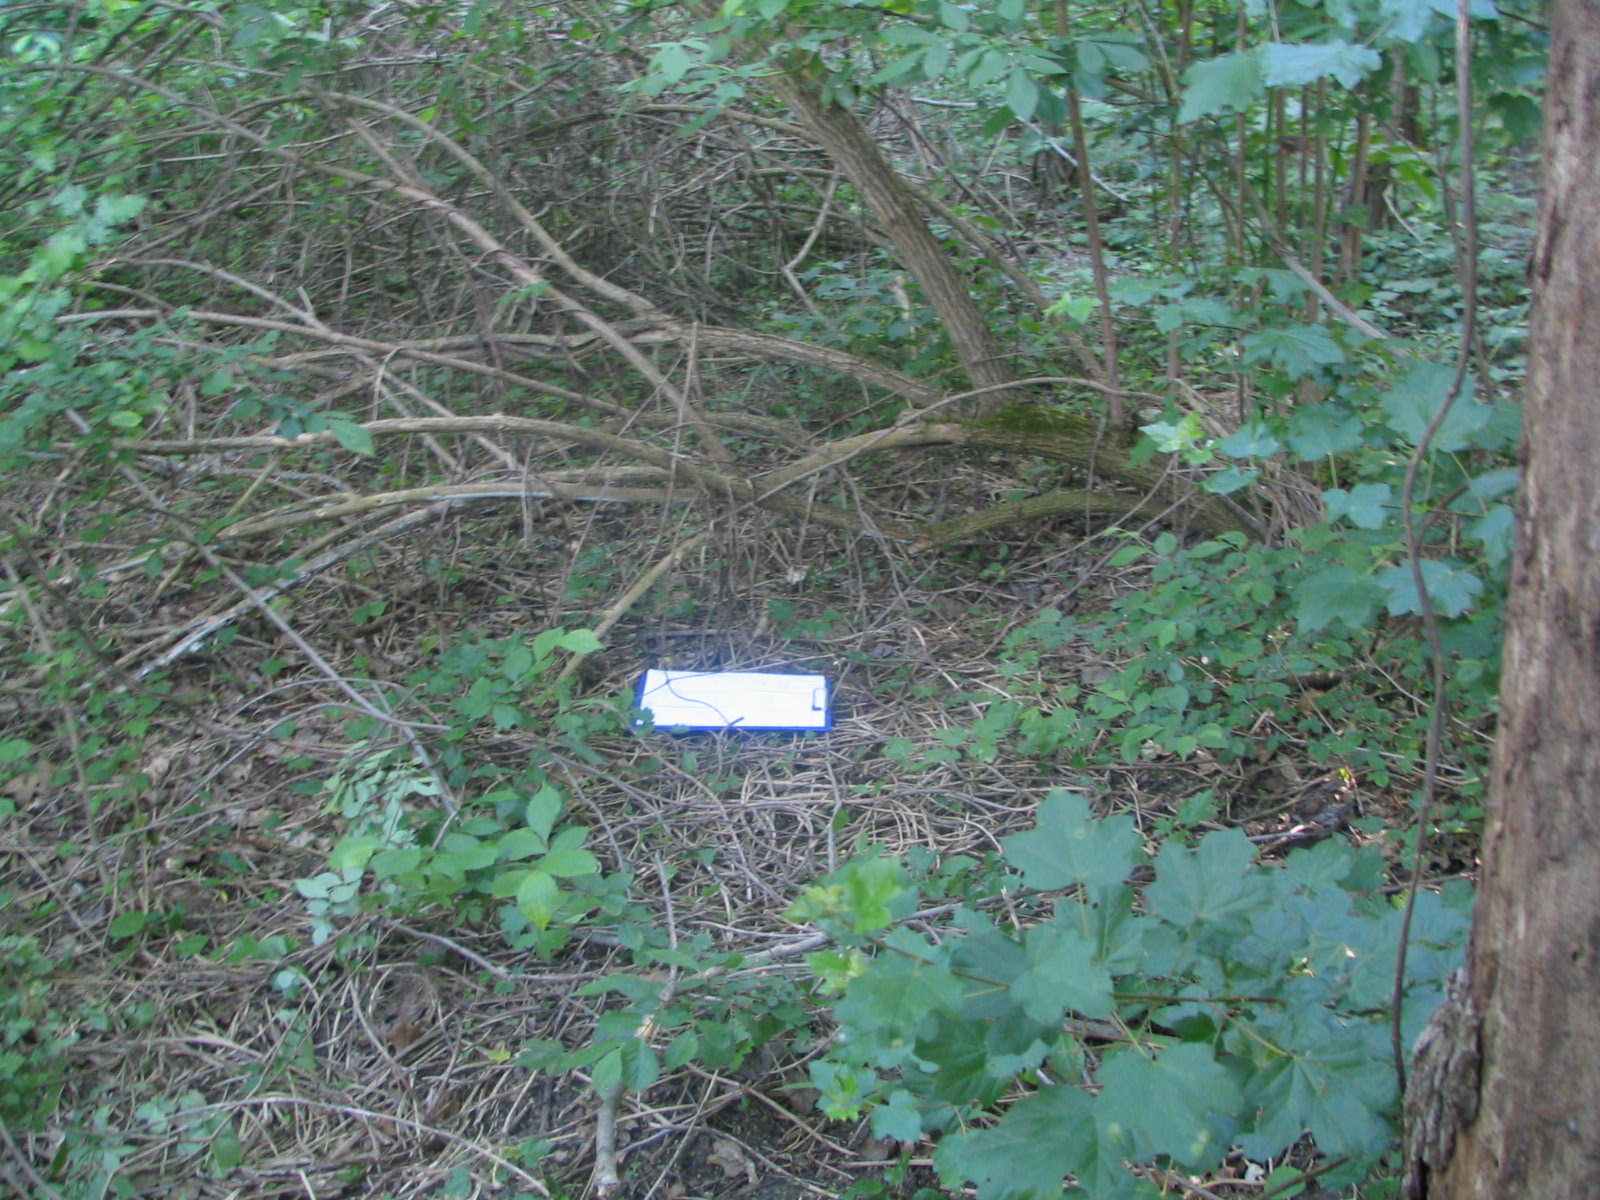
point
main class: Woodland
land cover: Broadleaved woodland
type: mesophytic deciduous forest
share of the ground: > 75 %
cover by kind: broadleaved forest trees 90 %, shrubs 5 %, herbaceous plants 5 %
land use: Forestry
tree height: > 5 m
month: May
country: BG
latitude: 43.6803
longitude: 24.0602
